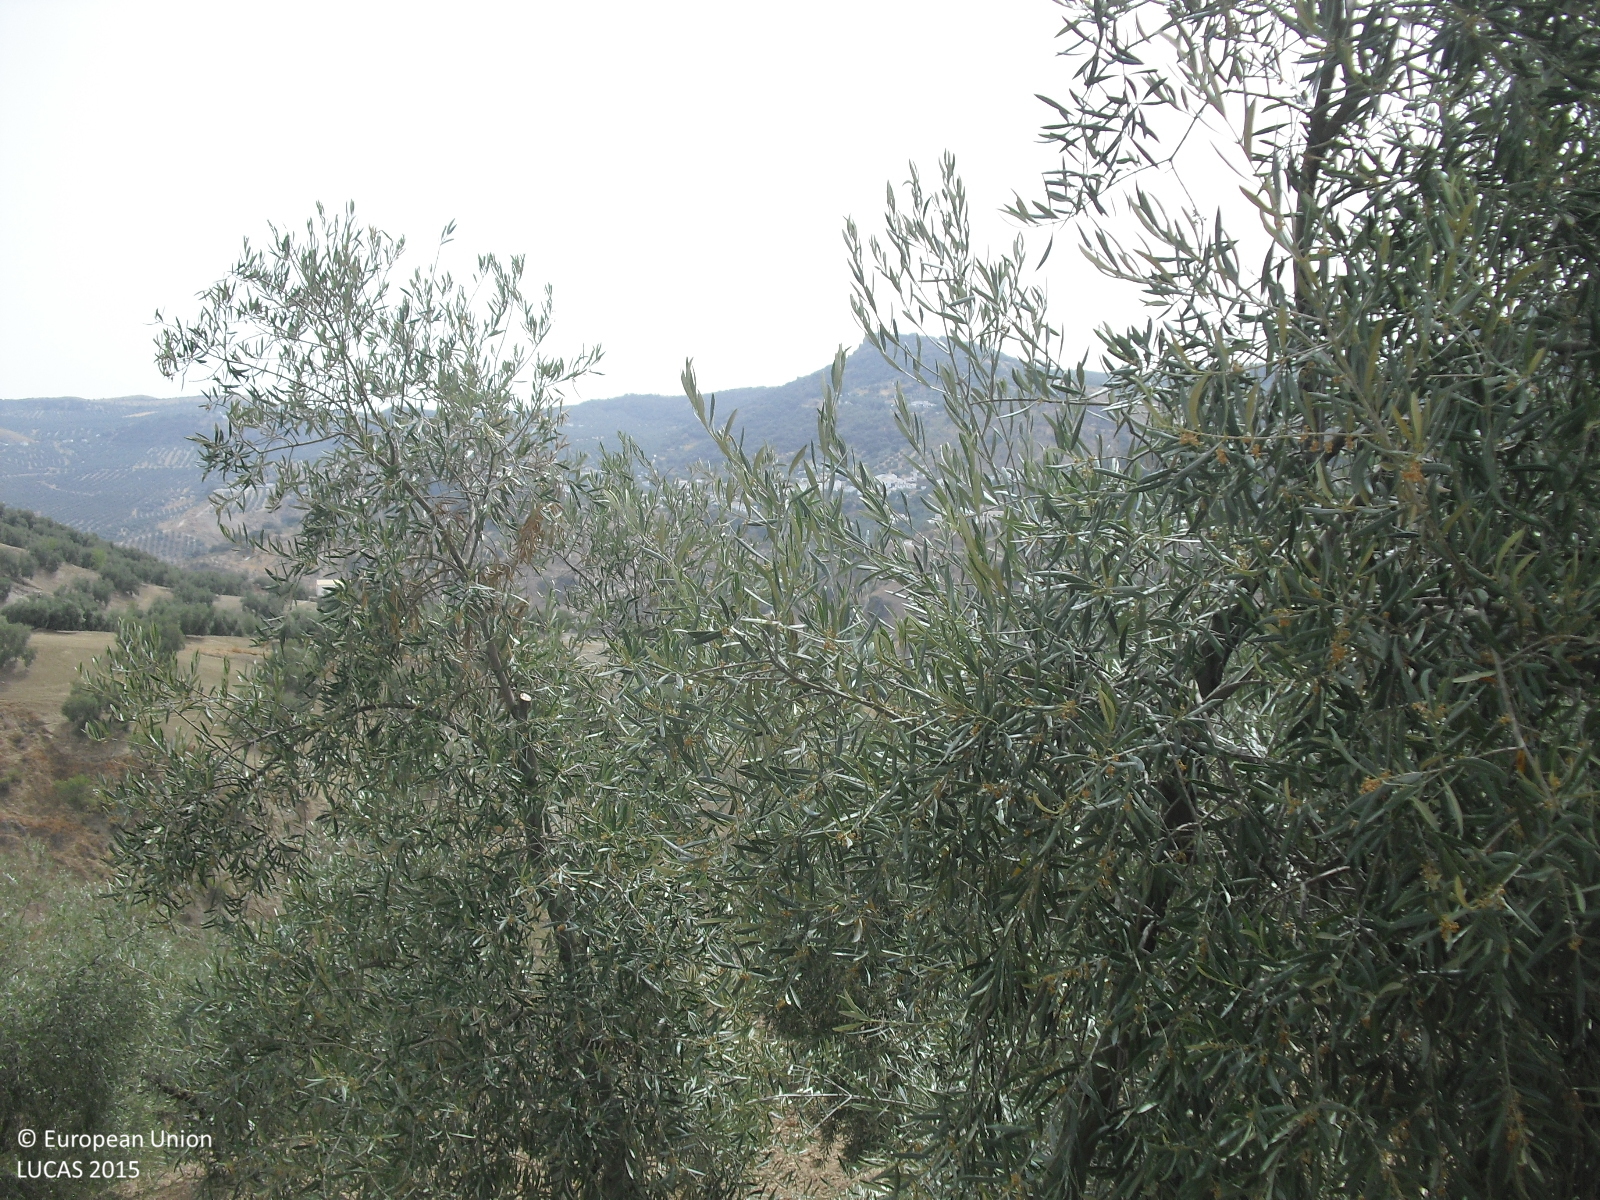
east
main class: Cropland
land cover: Olive groves
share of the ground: 25 - 50 %
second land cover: Other bare soil
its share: > 75 %
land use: Agriculture (excluding fallow land and kitchen gardens)
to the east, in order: Olive groves; Other bare soil; Shrubland without tree cover; Other structural elements; Shrubland without tree cover; Other structural elements; Shrubland without tree cover; Olive groves
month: August
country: ES
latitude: 37.2094
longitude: -4.3188
